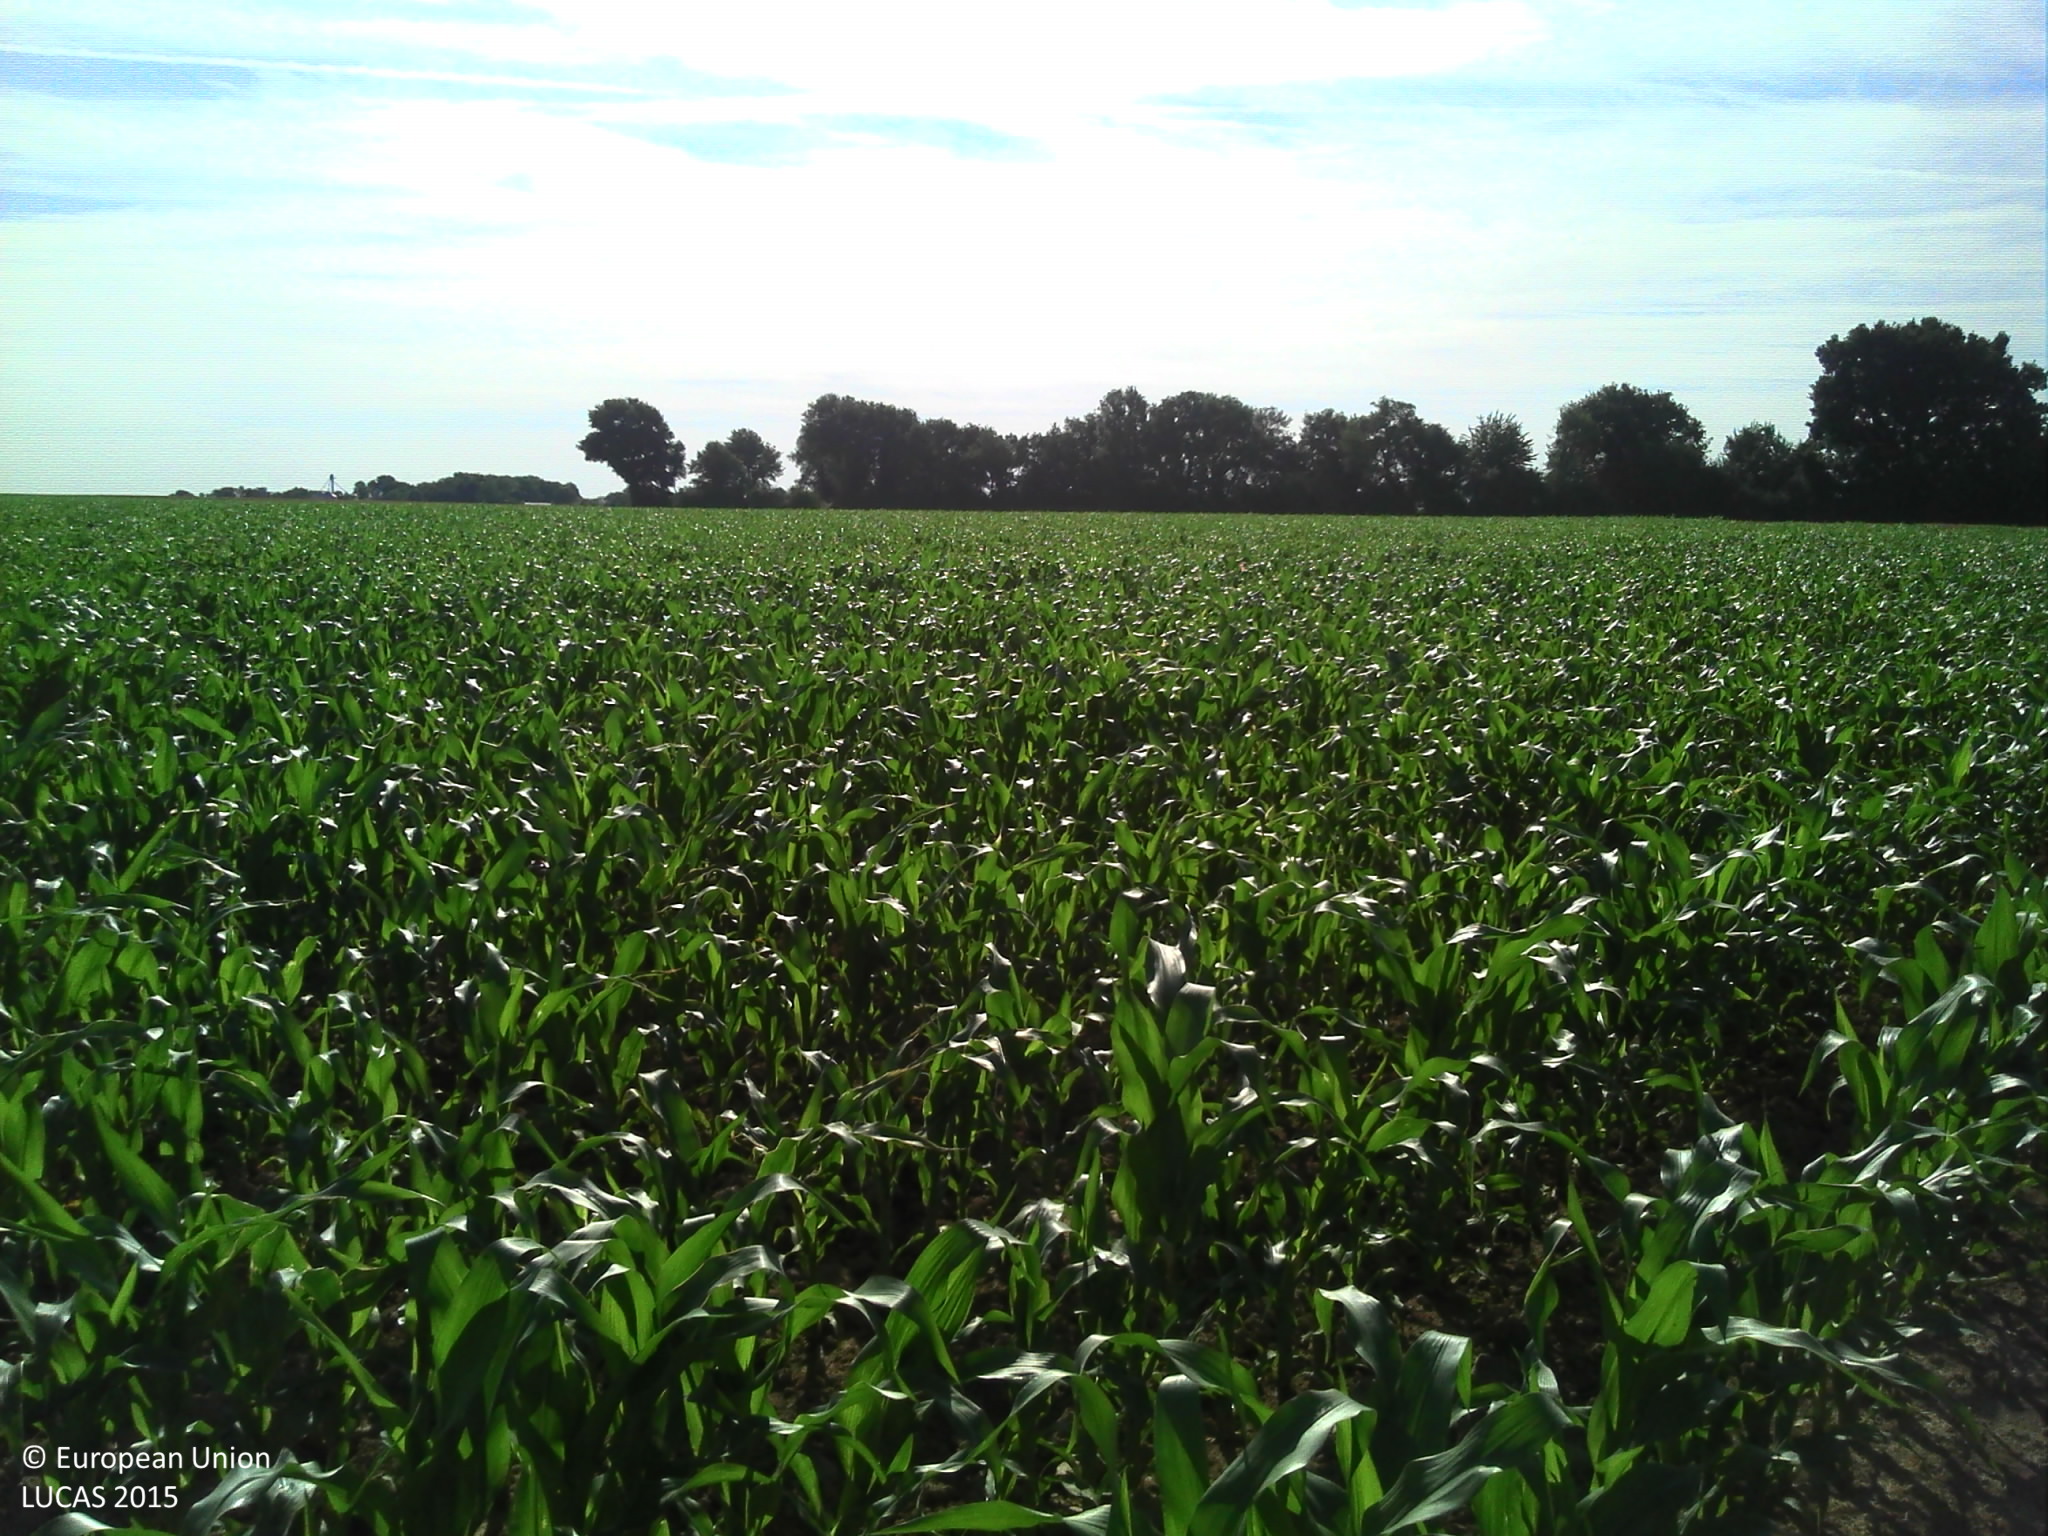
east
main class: Cropland
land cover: Maize
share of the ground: > 75 %
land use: Agriculture (excluding fallow land and kitchen gardens)
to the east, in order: Maize; Common wheat
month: June
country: FR
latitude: 46.5029
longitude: 0.2463
